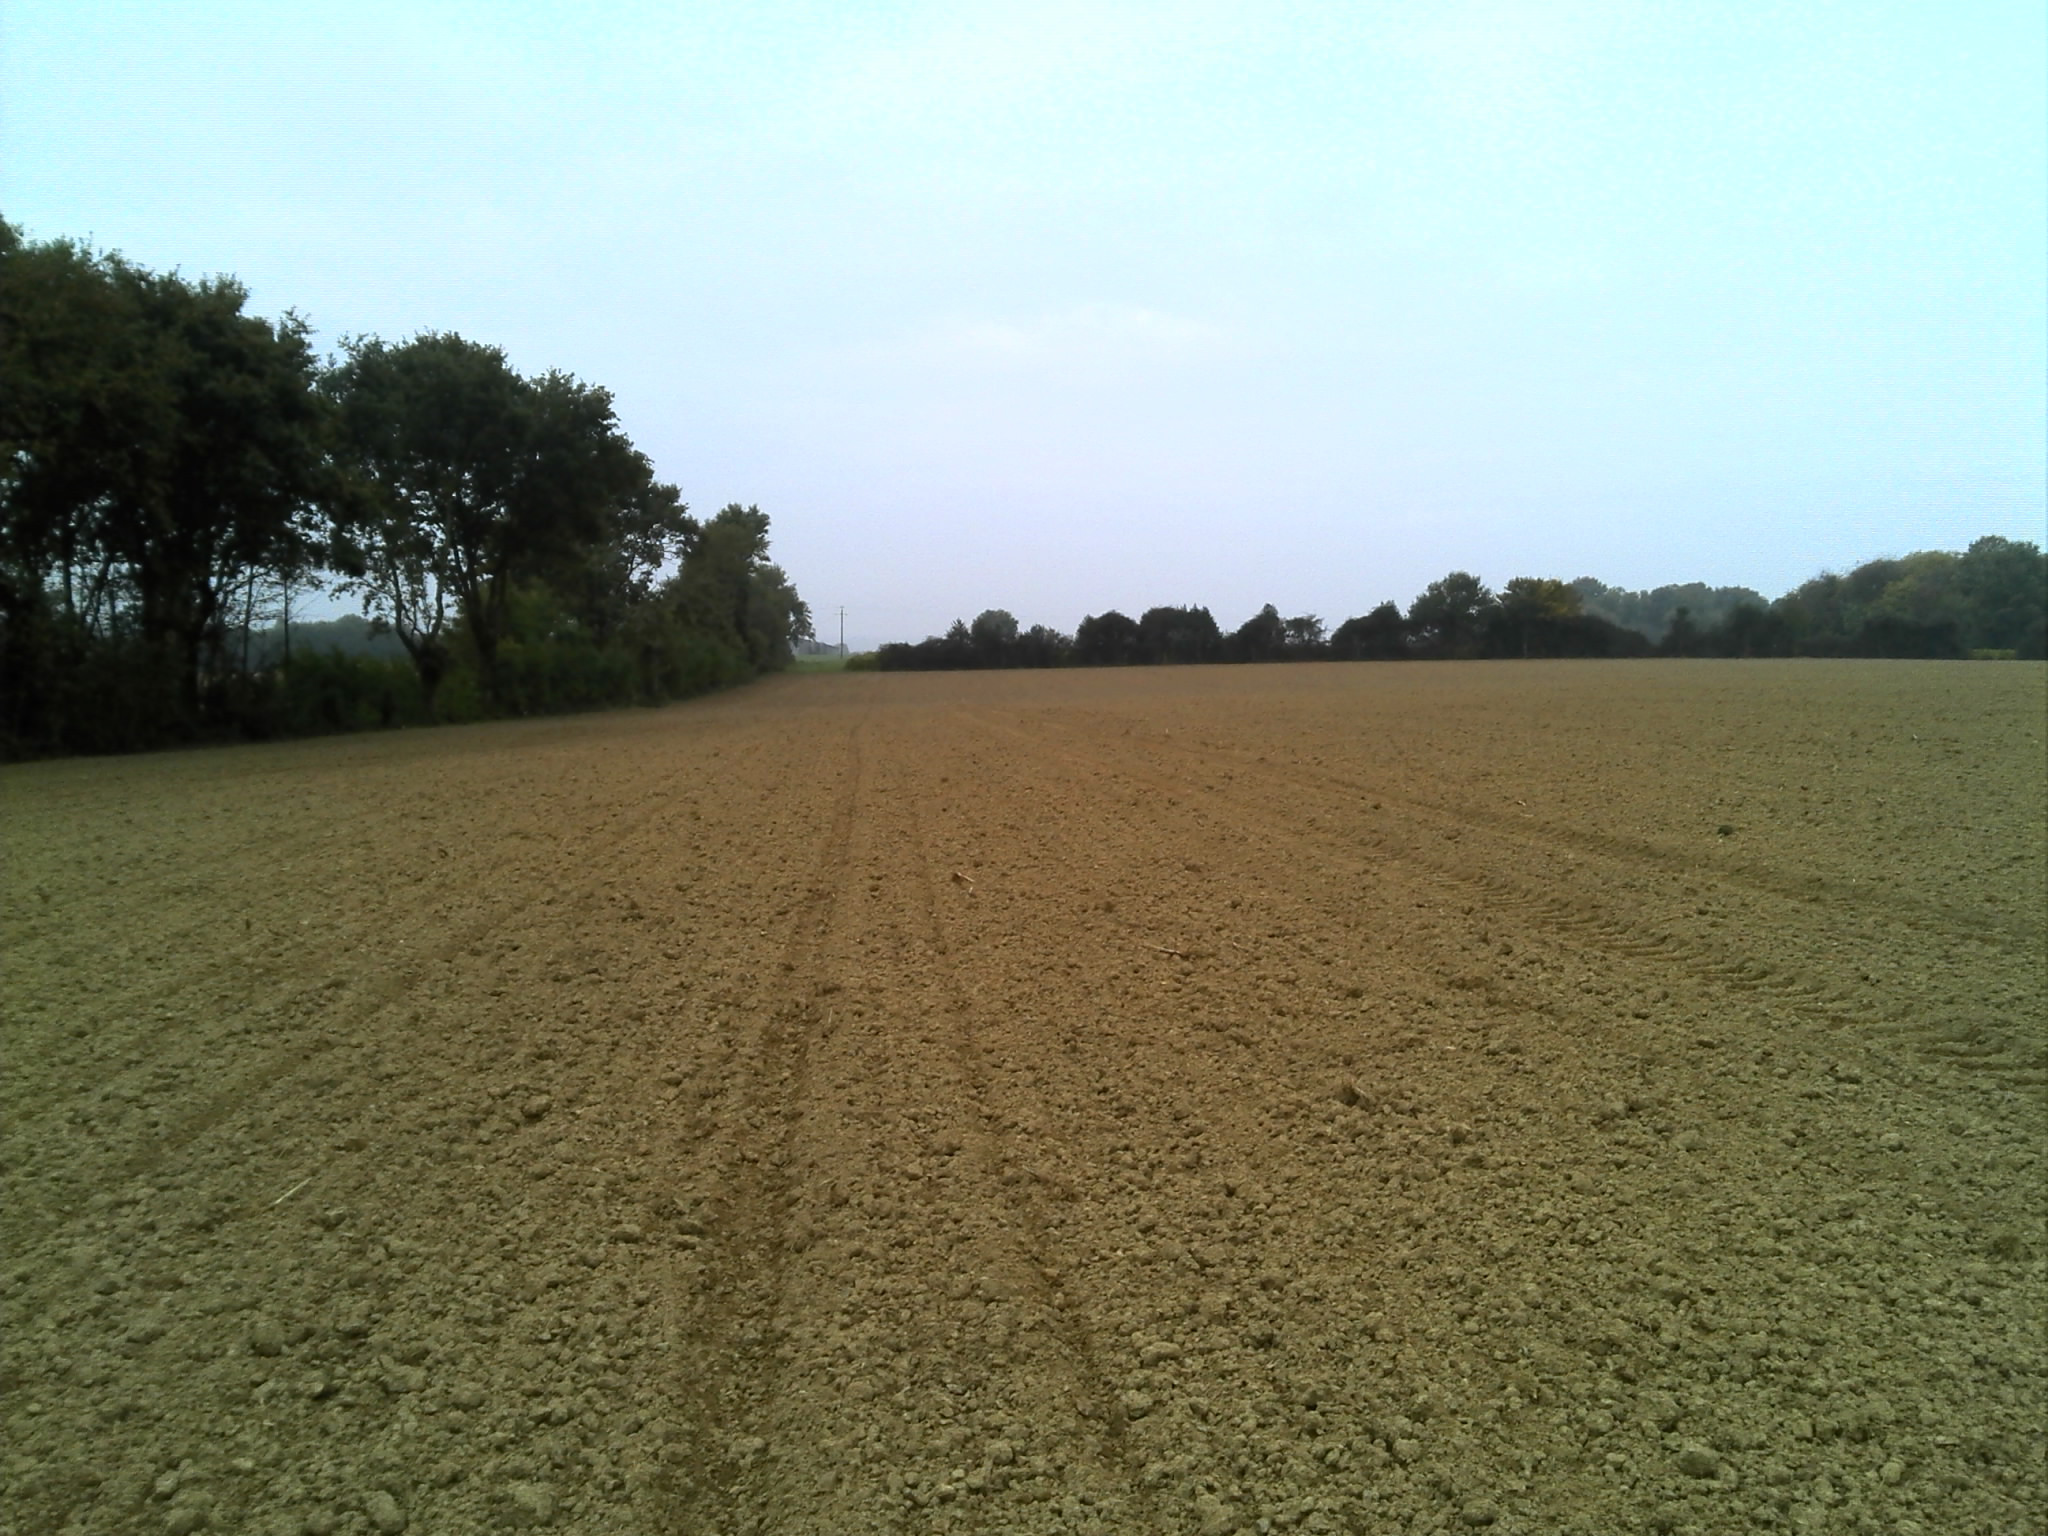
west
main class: Cropland
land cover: Common wheat
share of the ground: < 10 %
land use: Agriculture (excluding fallow land and kitchen gardens)
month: October
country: FR
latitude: 47.3133
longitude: -0.9487
